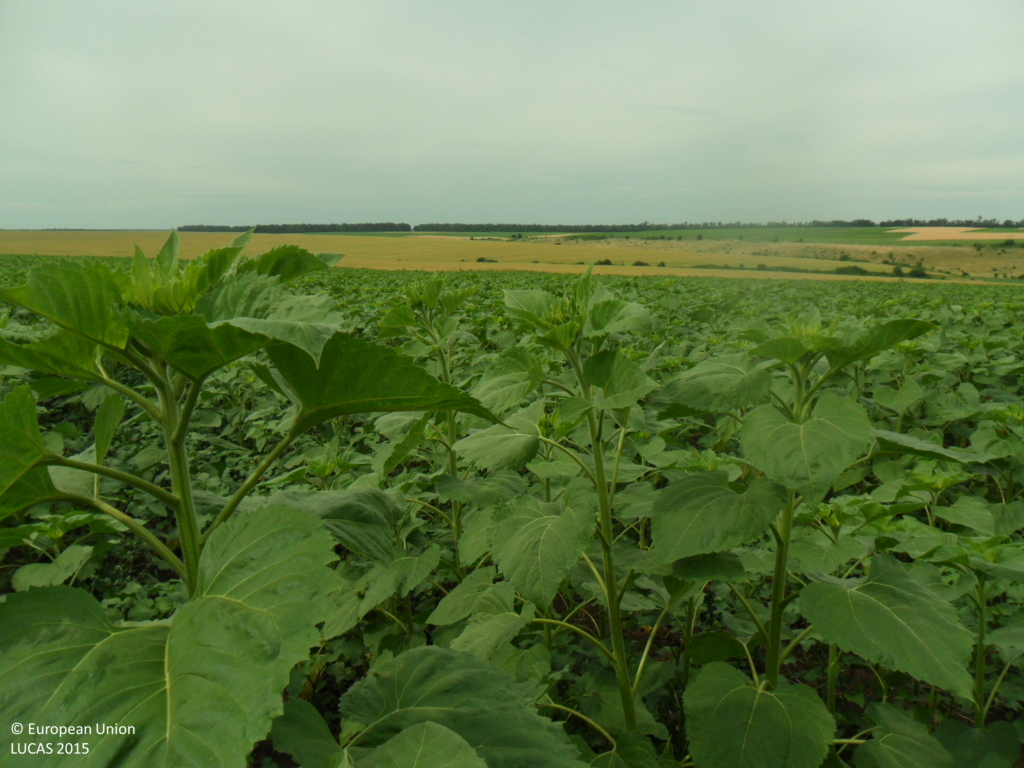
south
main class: Cropland
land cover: Sunflower
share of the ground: > 75 %
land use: Agriculture (excluding fallow land and kitchen gardens)
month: June
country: BG
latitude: 43.7105
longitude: 26.9857
